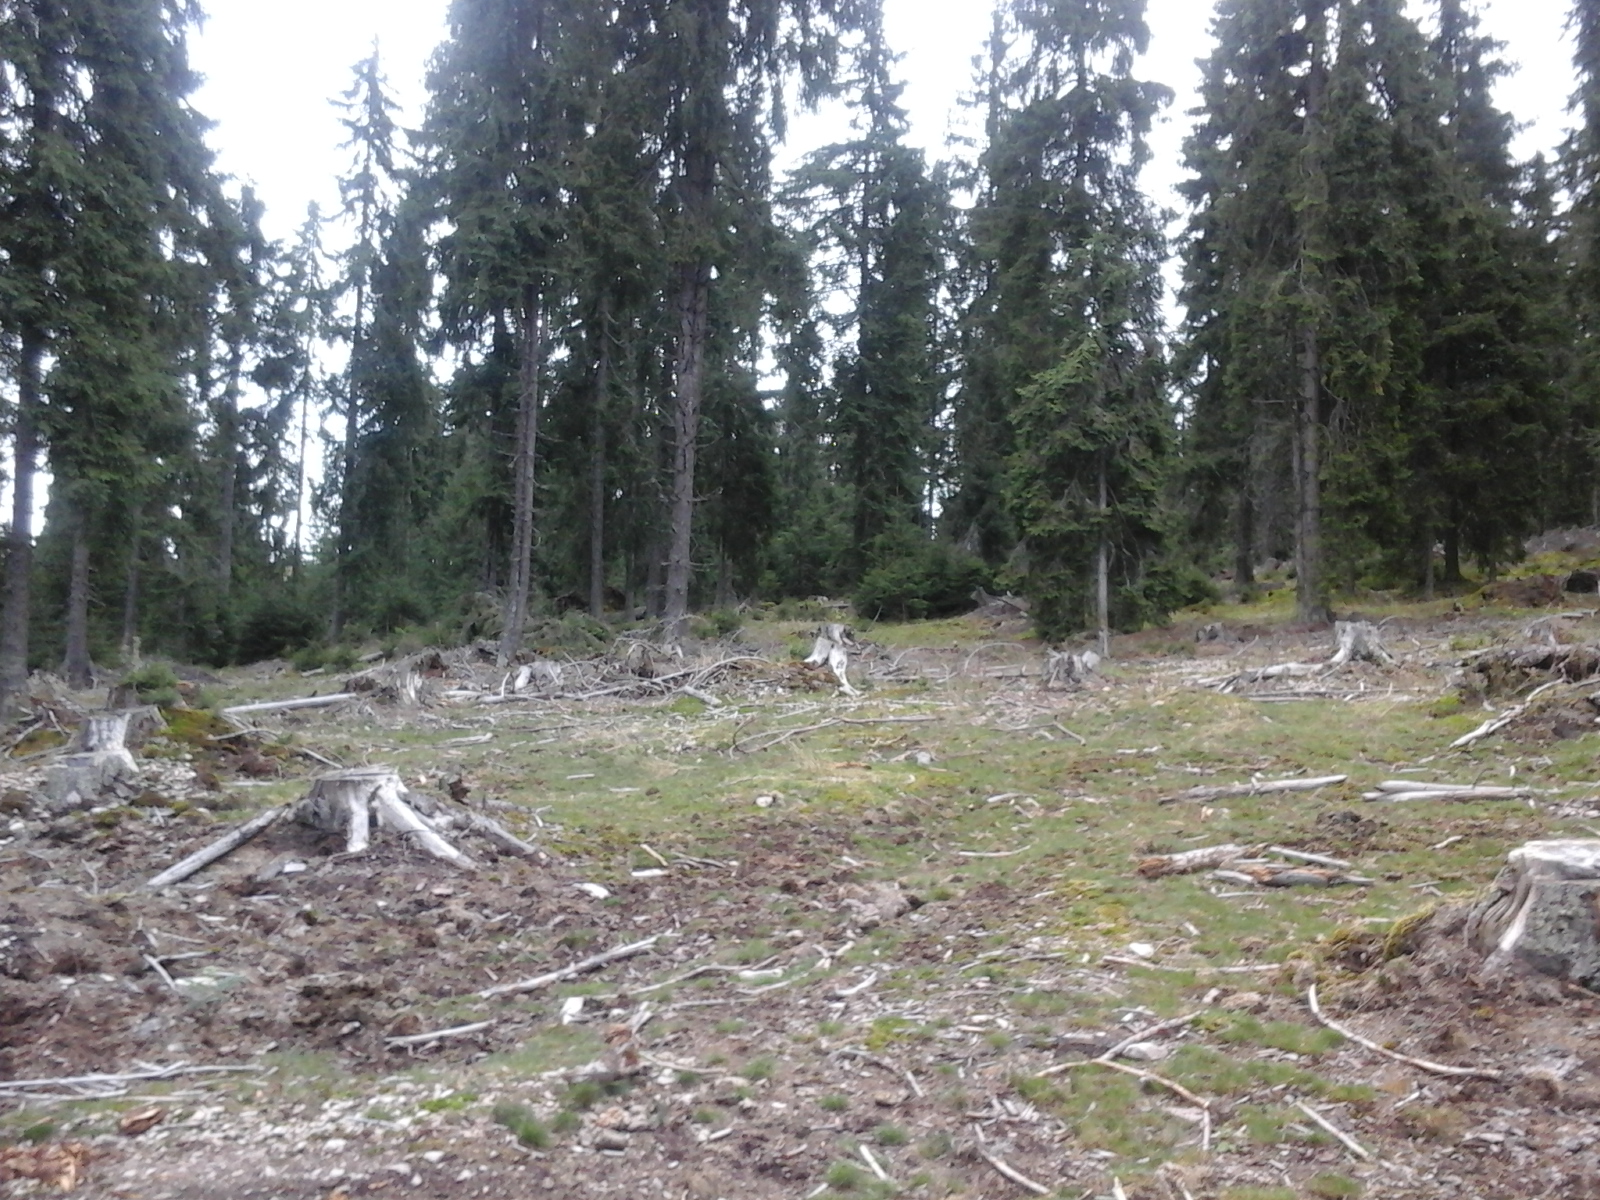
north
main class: Grassland
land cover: Grassland with sparse tree/shrub cover
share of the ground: > 75 %
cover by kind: herbaceous plants 95 %, coniferous forest trees 5 %
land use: Forestry
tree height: > 5 m
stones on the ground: 10 - 25 %
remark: Clear cut
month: September
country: RO
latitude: 46.5386
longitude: 22.8488
